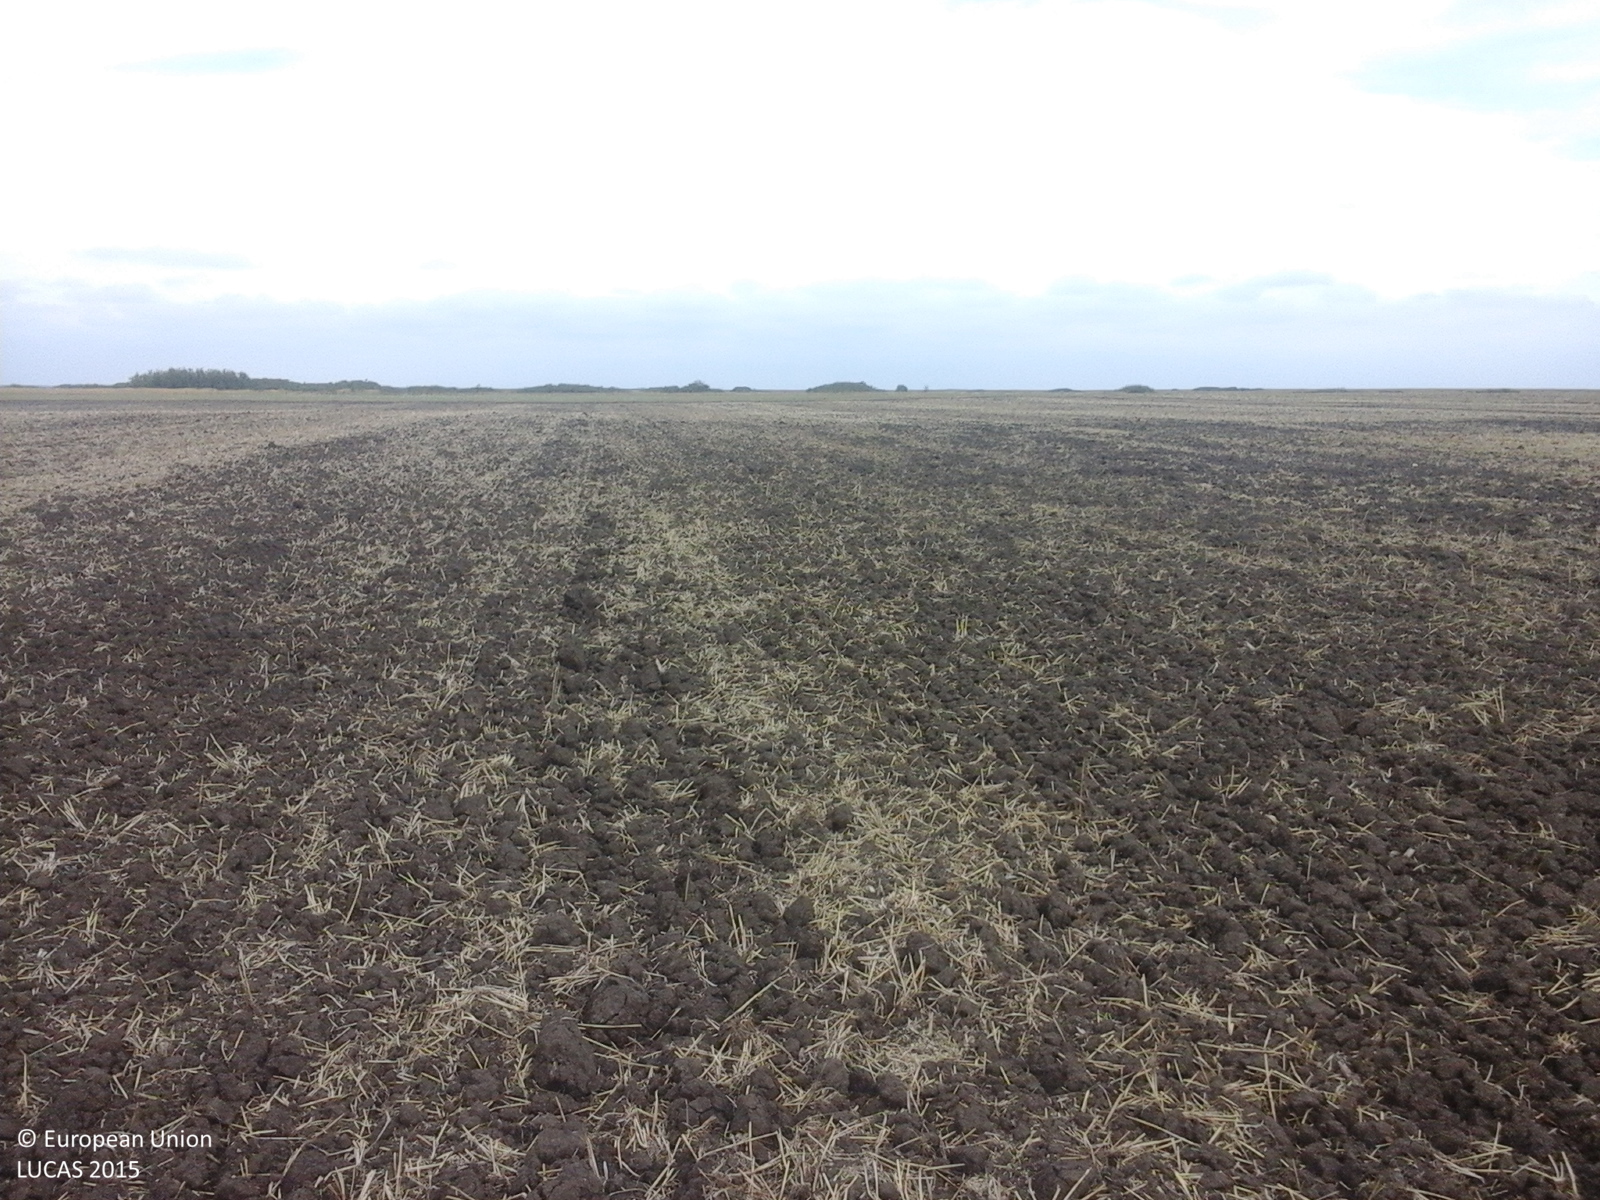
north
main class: Cropland
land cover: Common wheat
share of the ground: < 10 %
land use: Agriculture (excluding fallow land and kitchen gardens)
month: August
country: RO
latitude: 45.2970
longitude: 21.2885
